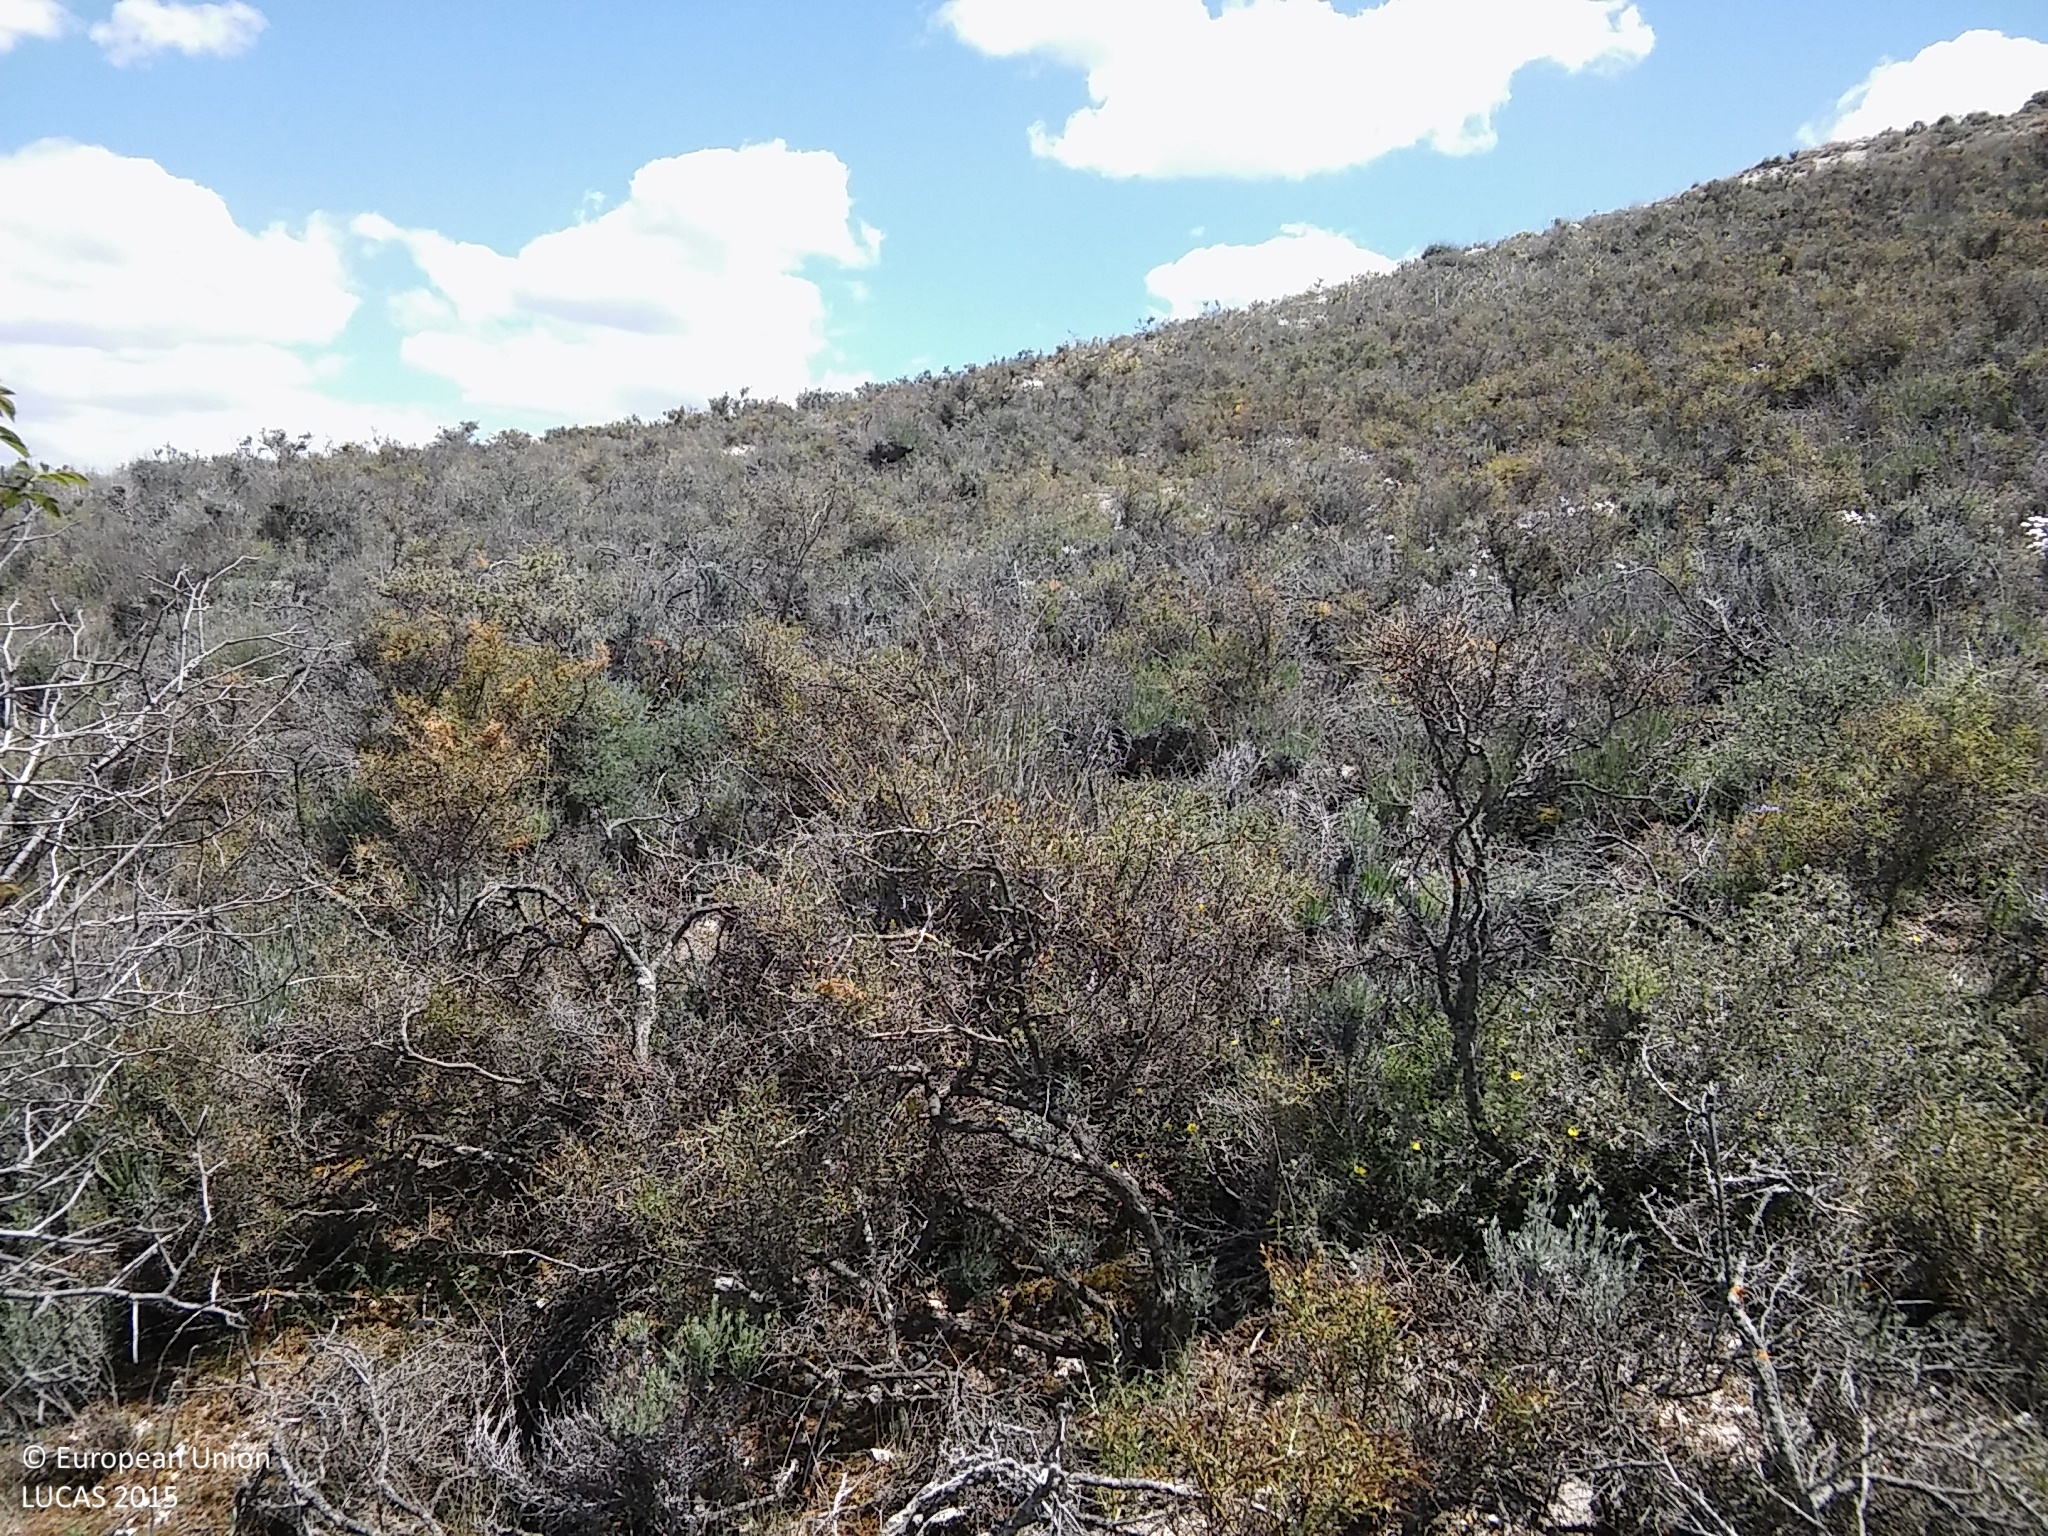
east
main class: Shrubland
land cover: Shrubland with sparse tree cover
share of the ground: > 75 %
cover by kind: shrubs 75 %, unconsolidated bare surface 20 %, coniferous forest trees 5 %
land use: Semi-natural and natural areas not in use
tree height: > 5 m
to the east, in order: Shrubland with sparse tree cover; Shrubland without tree cover; Grass margins; Dry pulses
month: May
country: ES
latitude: 41.5865
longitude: -3.5933
